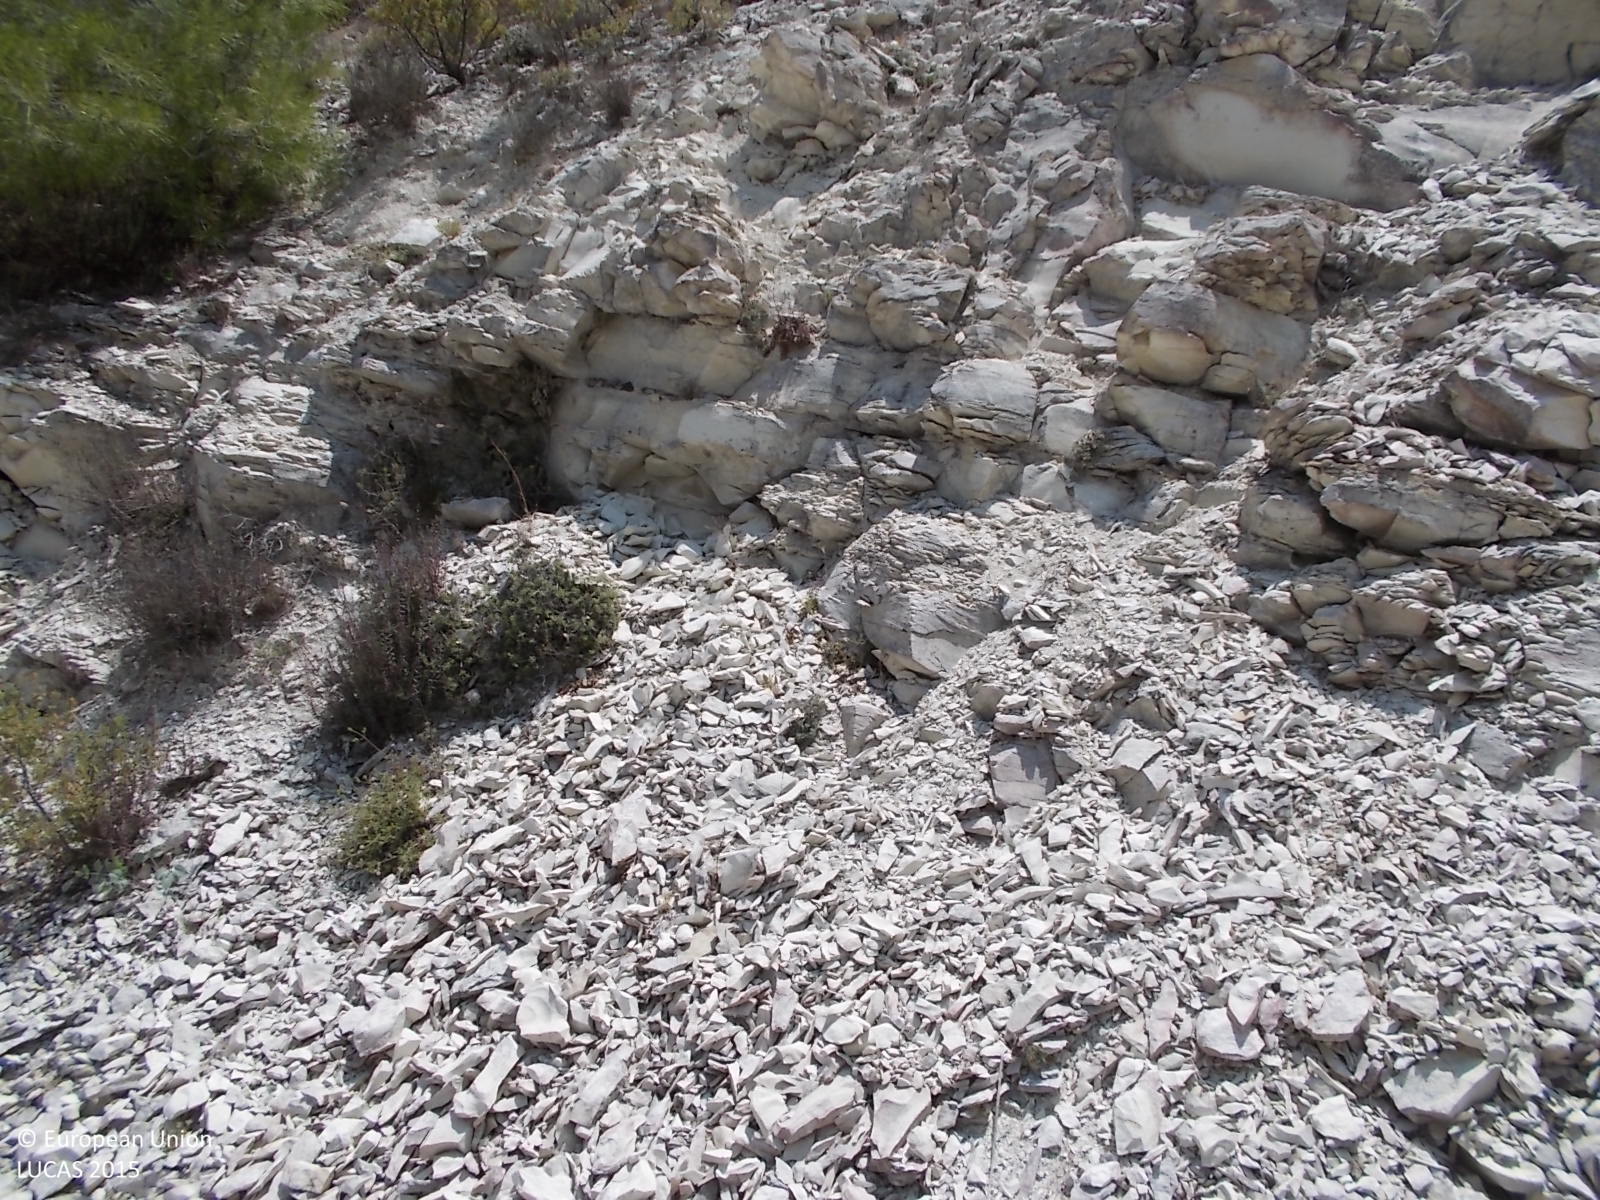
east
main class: Shrubland
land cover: Shrubland with sparse tree cover
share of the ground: > 75 %
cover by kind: shrubs 70 %, unconsolidated bare surface 15 %, consolidated bare surface 10 %, coniferous forest trees 5 %
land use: Semi-natural and natural areas not in use
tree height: > 5 m
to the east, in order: Shrubland with sparse tree cover; Shrubland without tree cover; Pine dominated coniferous woodland; Shrubland with sparse tree cover; Pine dominated coniferous woodland; Rocks and stones; Pine dominated coniferous woodland; Other bare soil; Pine dominated coniferous woodland
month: June
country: CY
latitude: 34.8705
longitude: 32.7729
